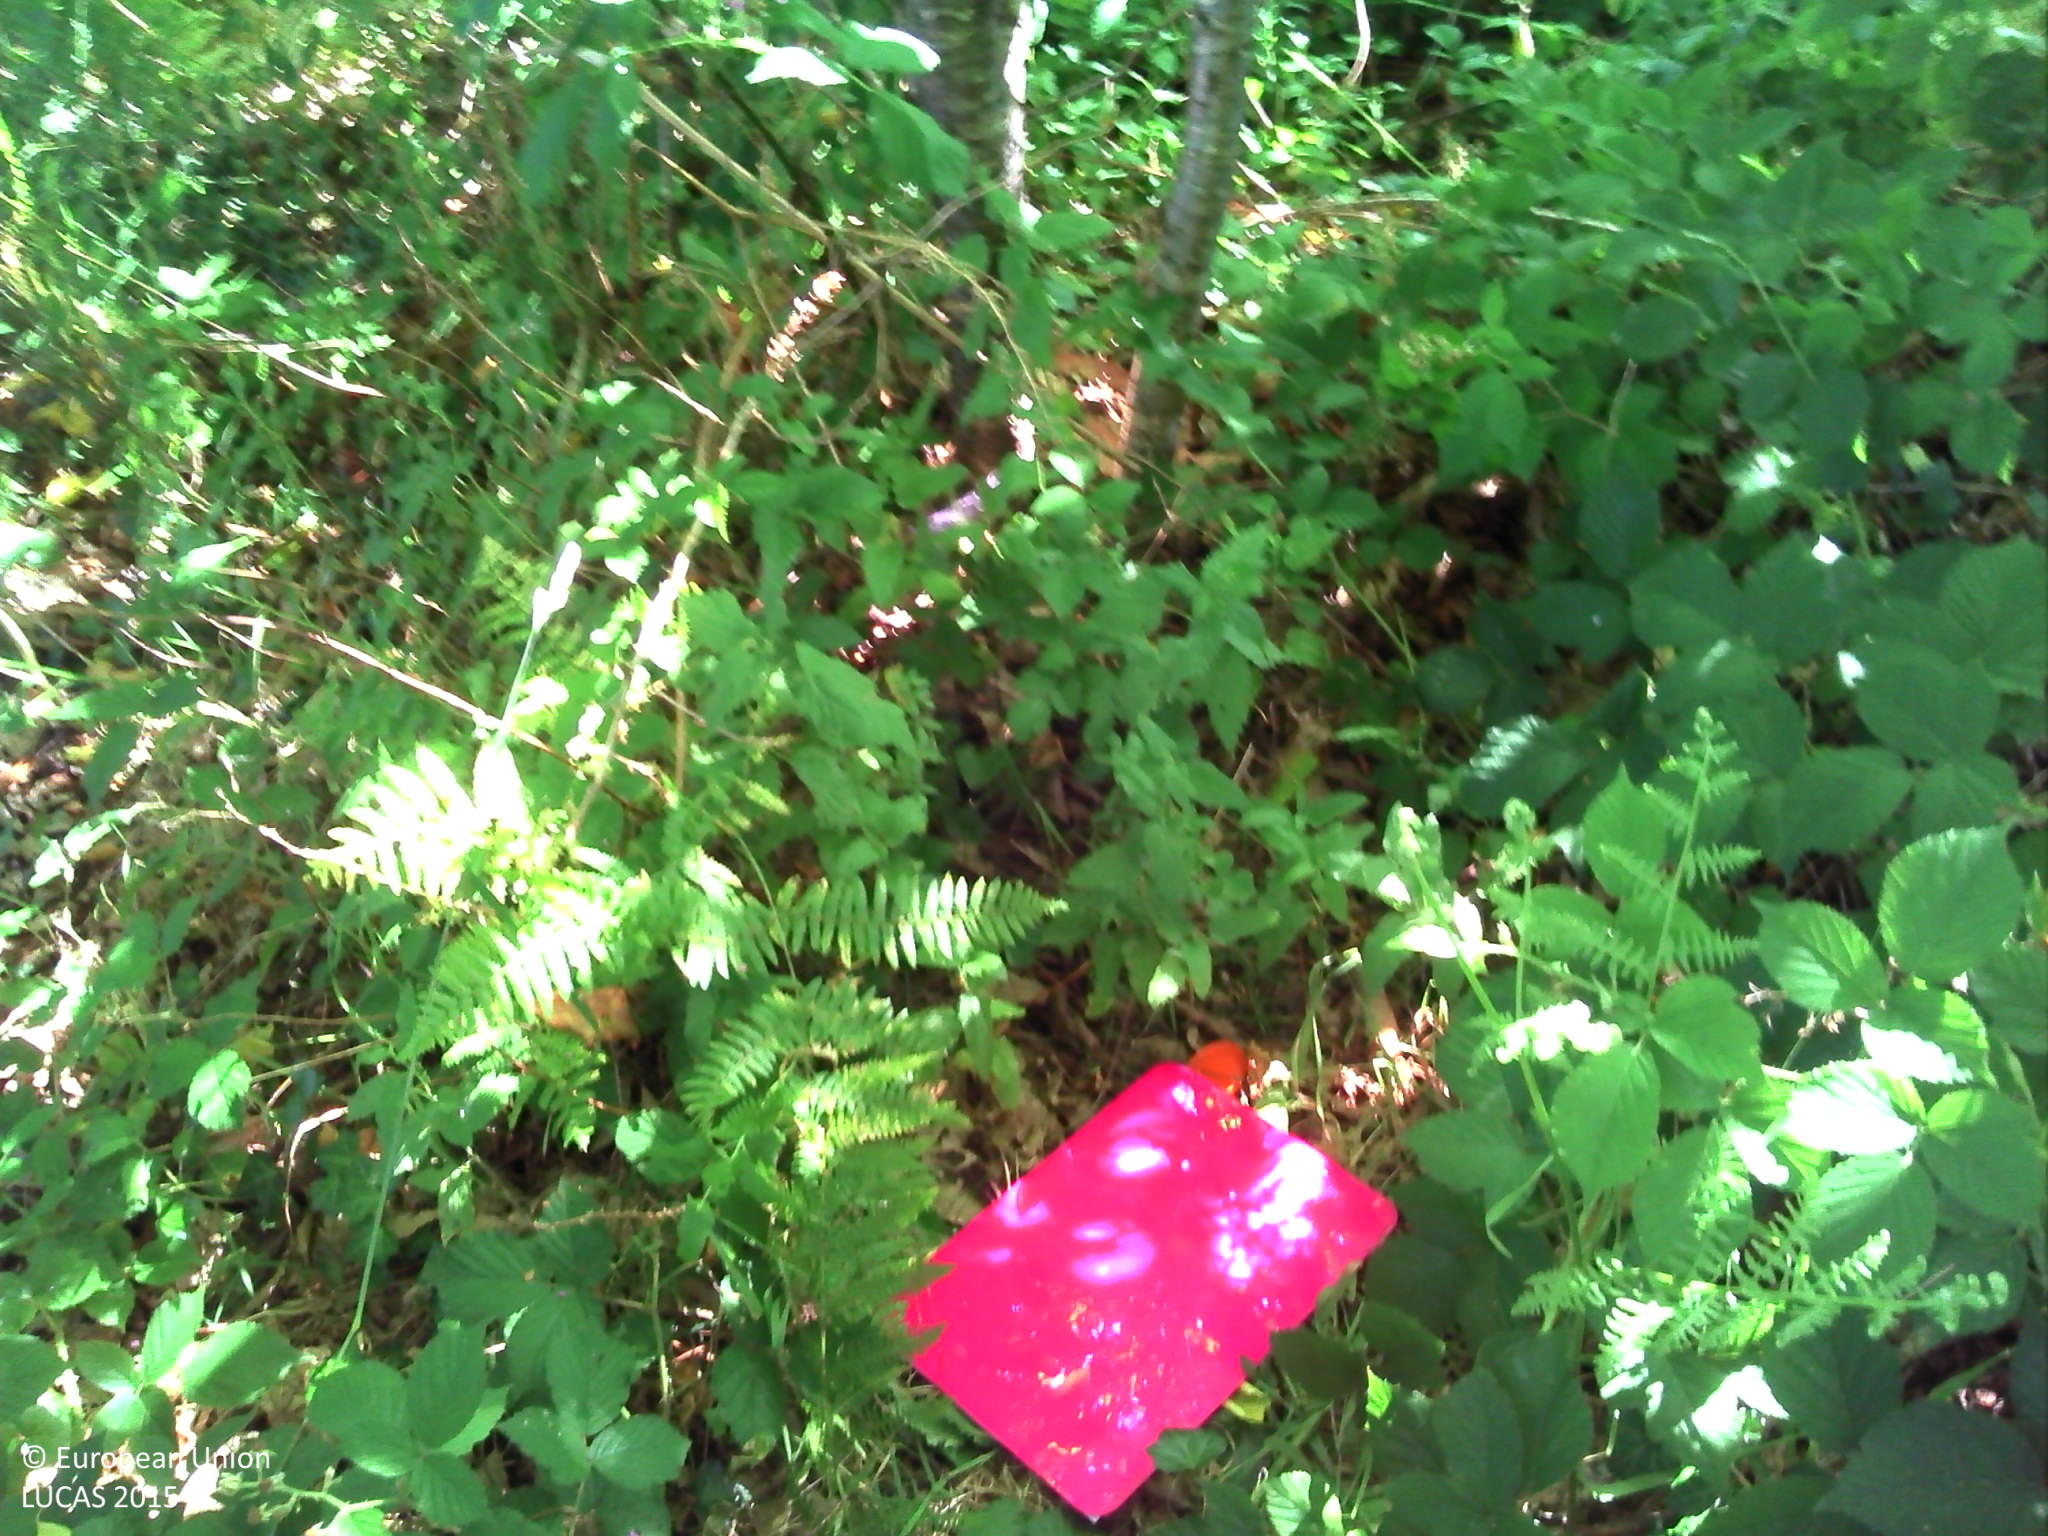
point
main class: Woodland
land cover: Broadleaved woodland
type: acidophilous oak and oak-birch forest
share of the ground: > 75 %
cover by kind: broadleaved forest trees 90 %, shrubs 5 %, herbaceous plants 5 %
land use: Forestry
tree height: > 5 m
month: July
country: FR
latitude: 46.0856
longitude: 1.2864
